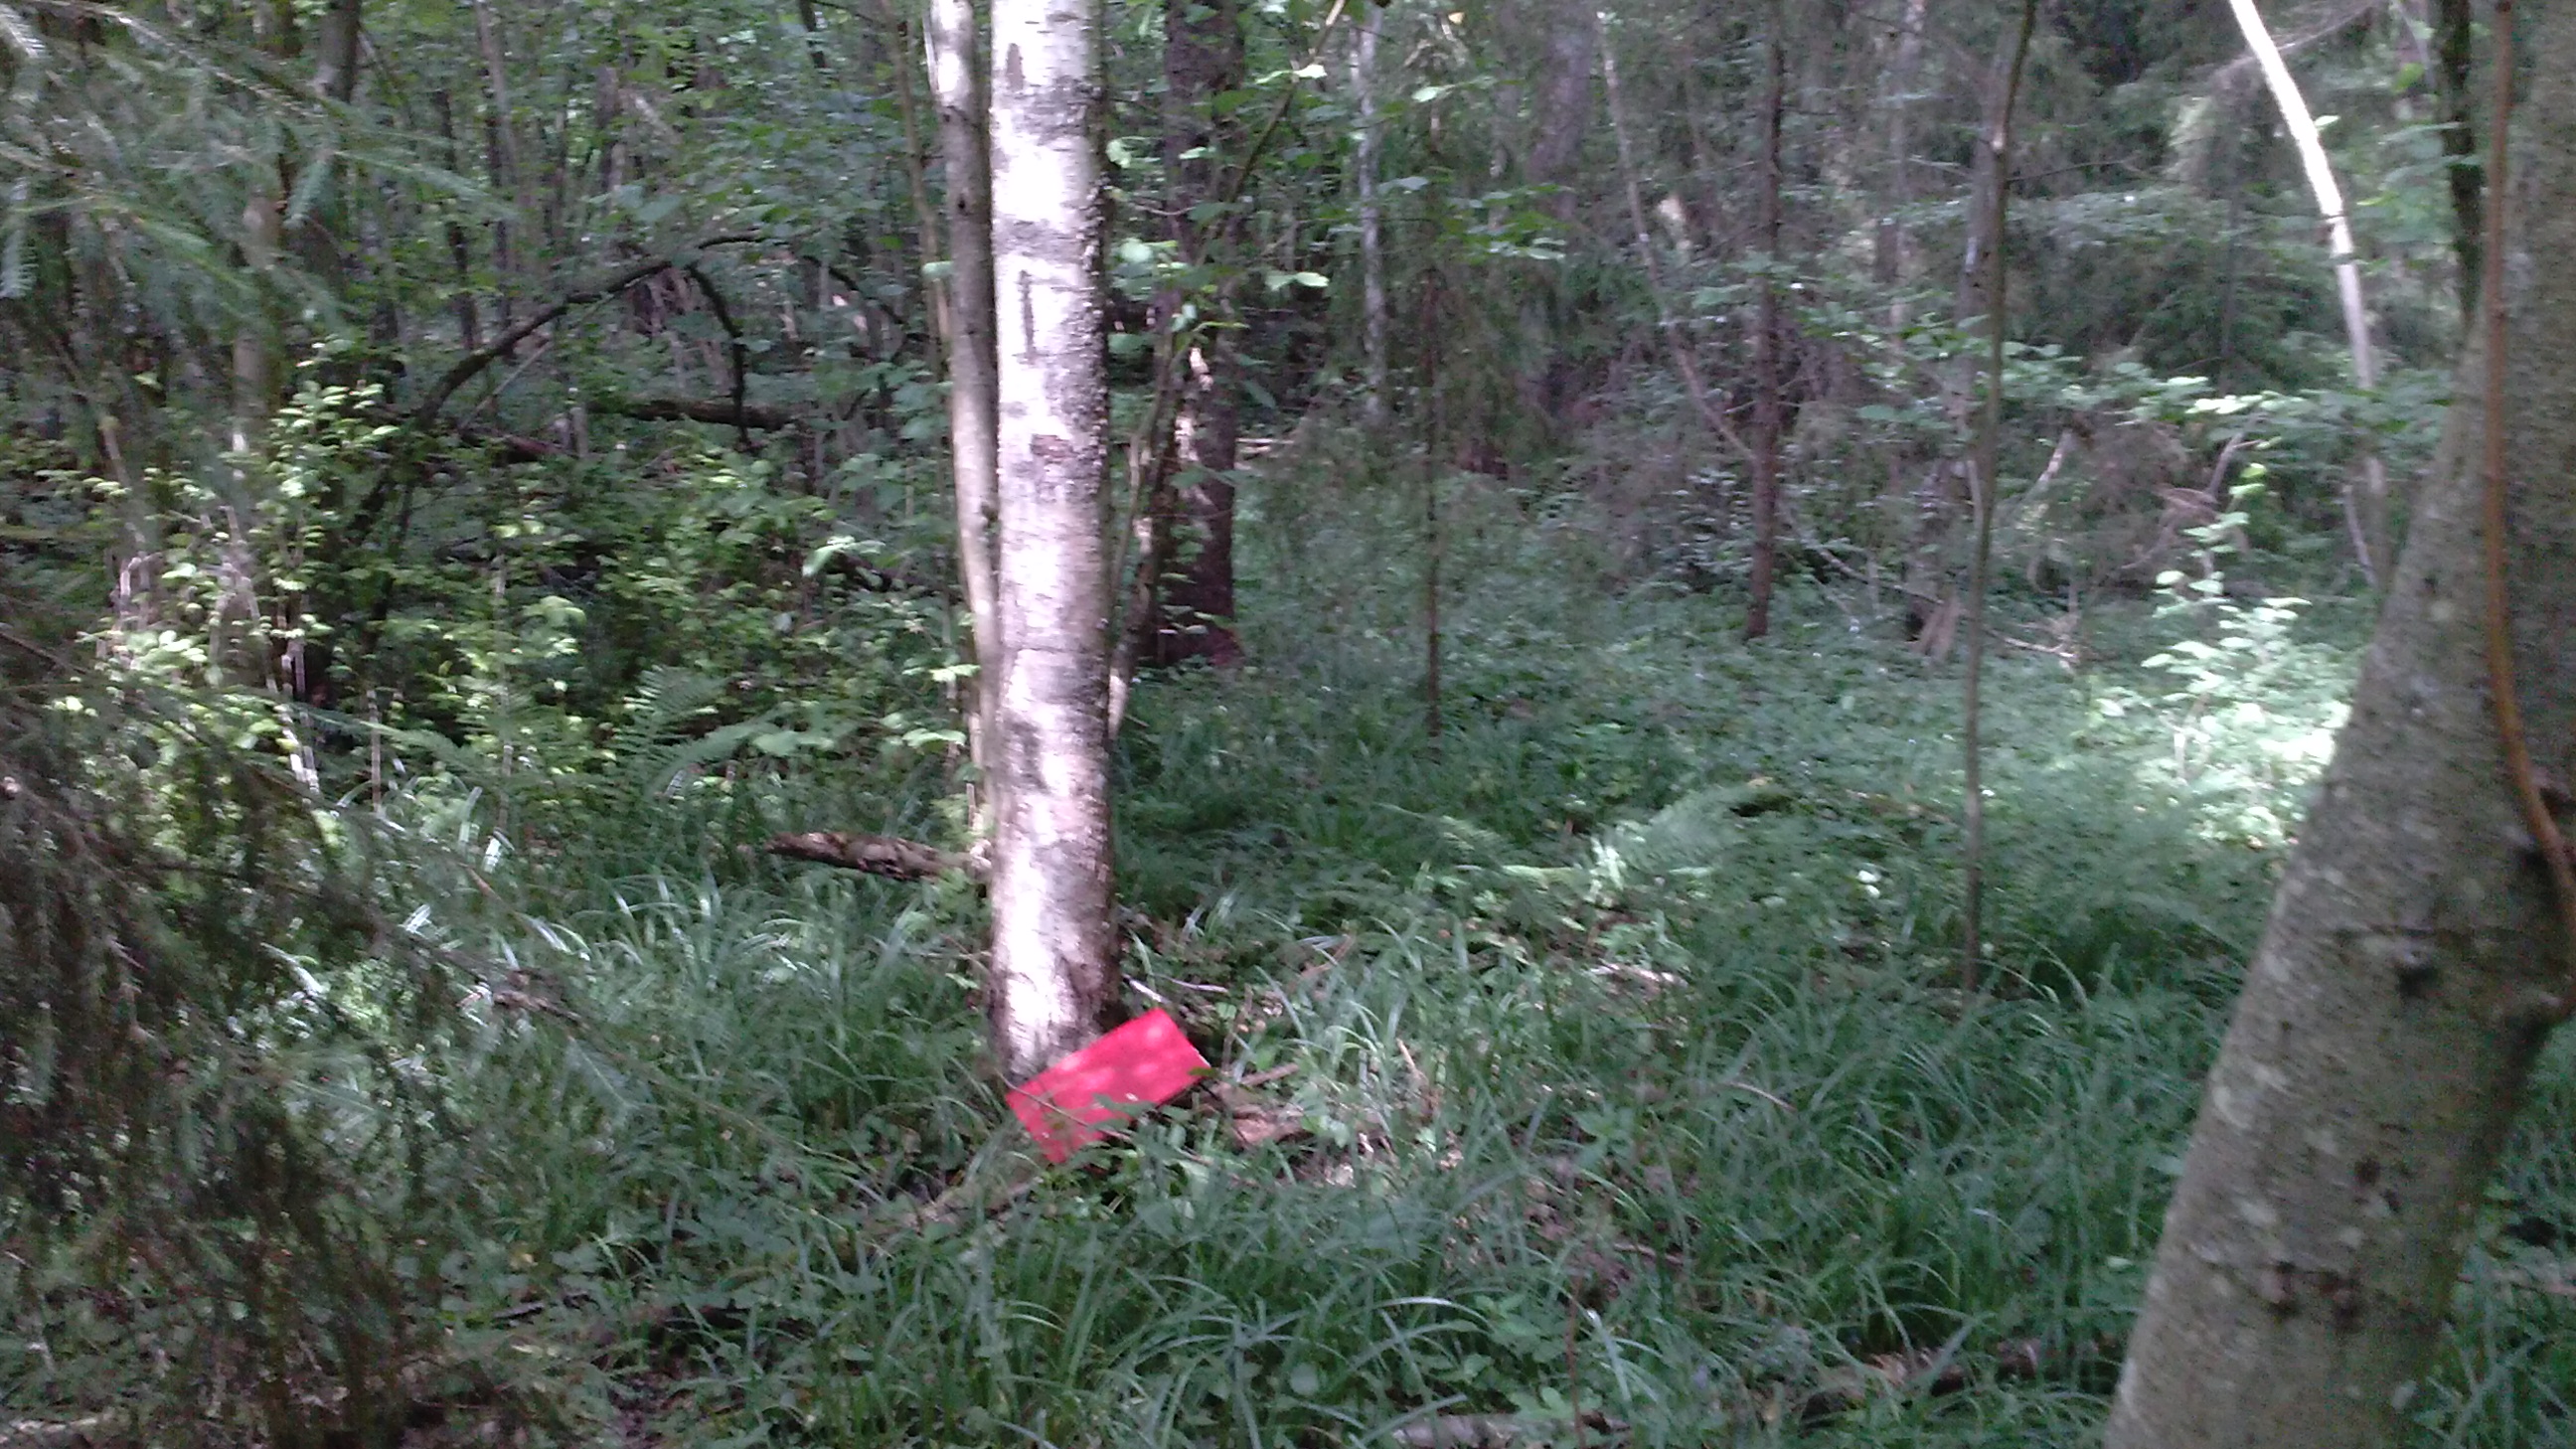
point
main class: Woodland
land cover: Spruce dominated mixed woodland
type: hemiboreal forest and nemoral coniferous forest and mixed broadleaved-coniferous forest
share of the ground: > 75 %
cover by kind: coniferous forest trees 55 %, broadleaved forest trees 30 %, herbaceous plants 10 %, shrubs 5 %
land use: Forestry
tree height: > 5 m
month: June
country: LV
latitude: 56.5784
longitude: 27.7524
